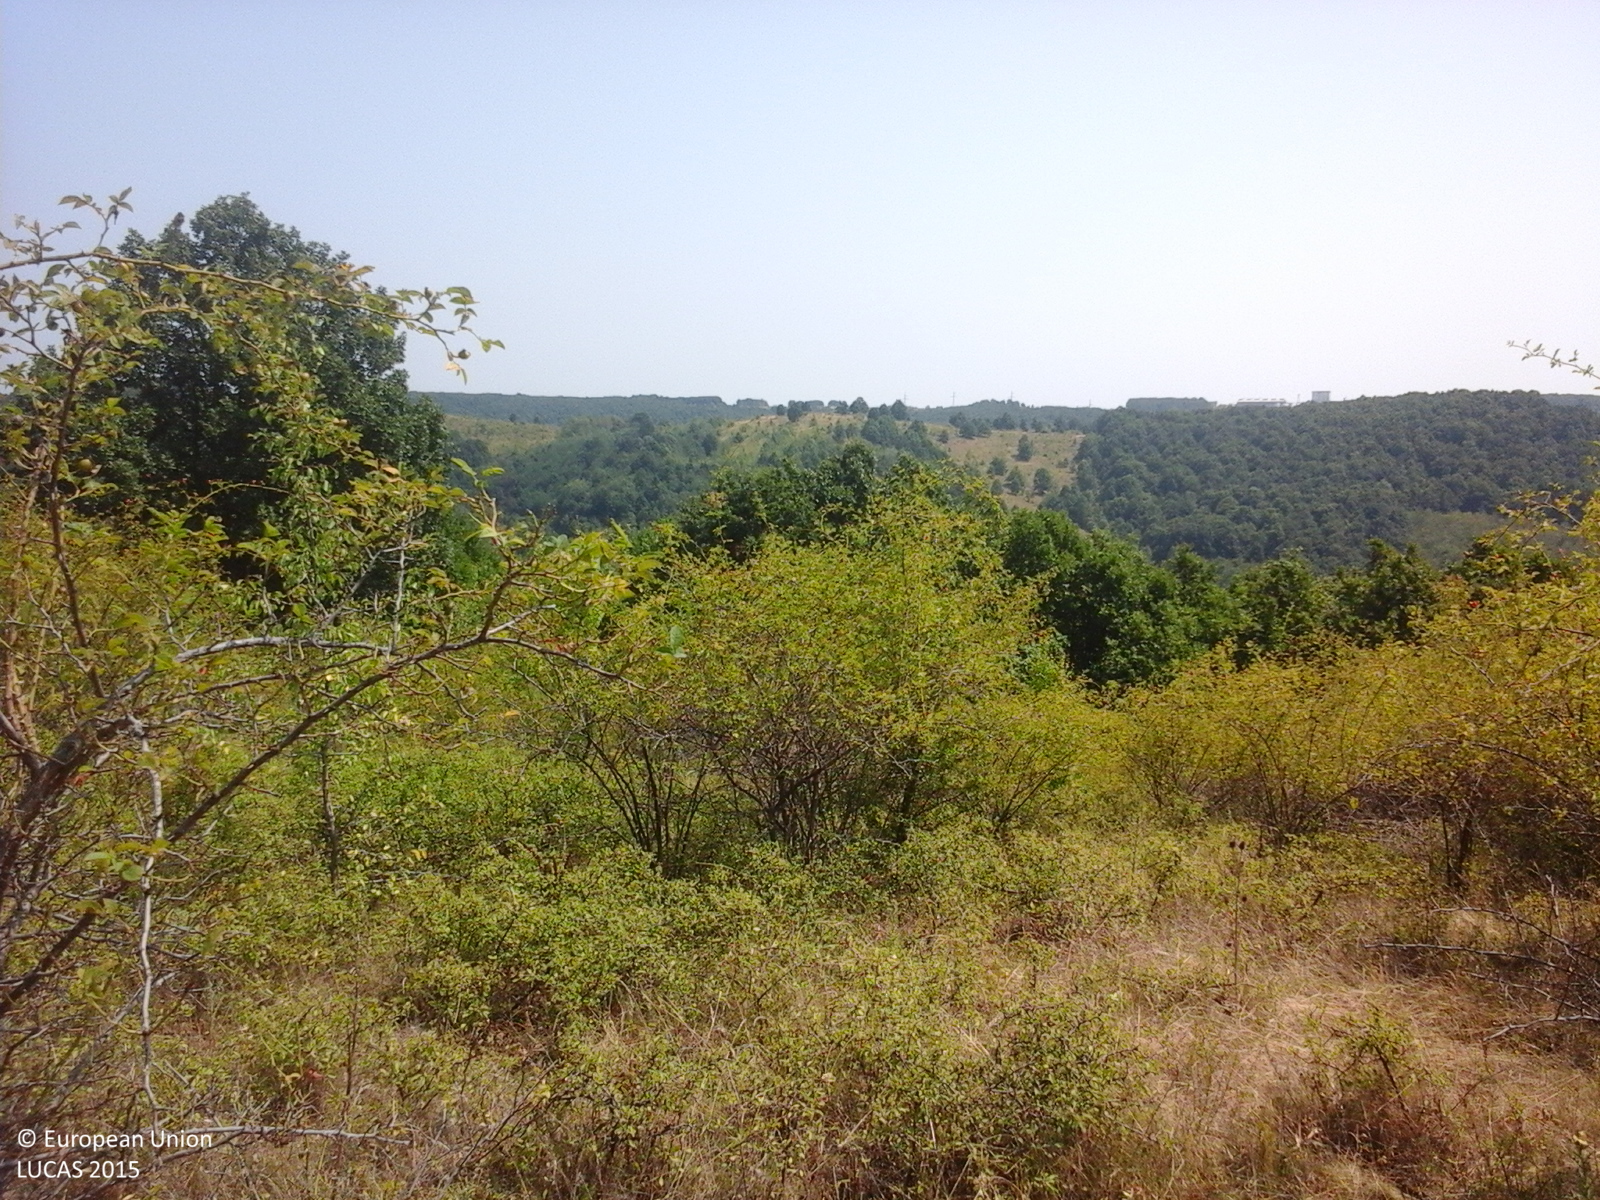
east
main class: Grassland
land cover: Grassland with sparse tree/shrub cover
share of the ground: > 75 %
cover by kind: herbaceous plants 85 %, shrubs 10 %, broadleaved forest trees 5 %
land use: Forestry
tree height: < 5 m
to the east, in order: Grassland with sparse tree/shrub cover; Broadleaved woodland; Pear fruit; Grassland with sparse tree/shrub cover
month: August
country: RO
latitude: 44.6799
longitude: 23.6958
